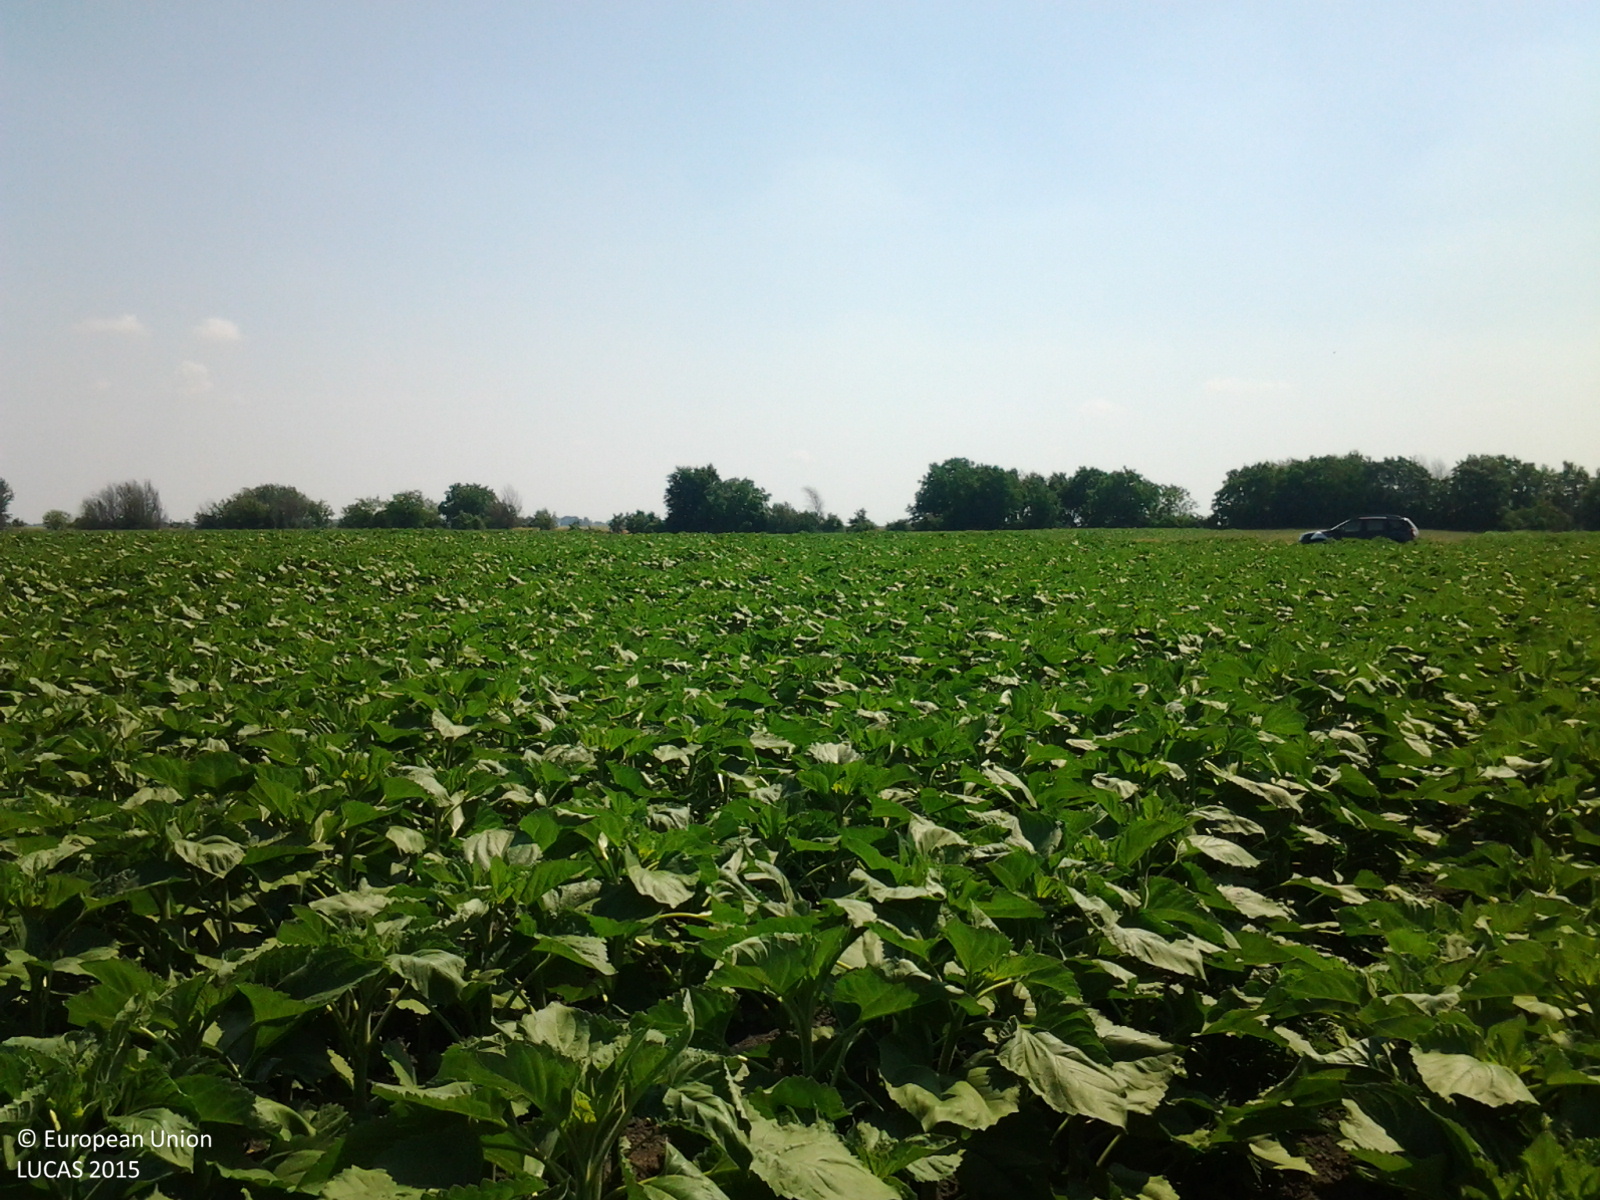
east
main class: Cropland
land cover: Sunflower
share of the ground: > 75 %
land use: Agriculture (excluding fallow land and kitchen gardens)
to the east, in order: Sunflower; Grass margins; Tracks; Grass margins; Sunflower; Grass margins; Lines of trees; Railways; Ditches and canals; Lines of trees; Grass margins; Barley
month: June
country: HU
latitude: 46.6581
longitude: 19.0183
